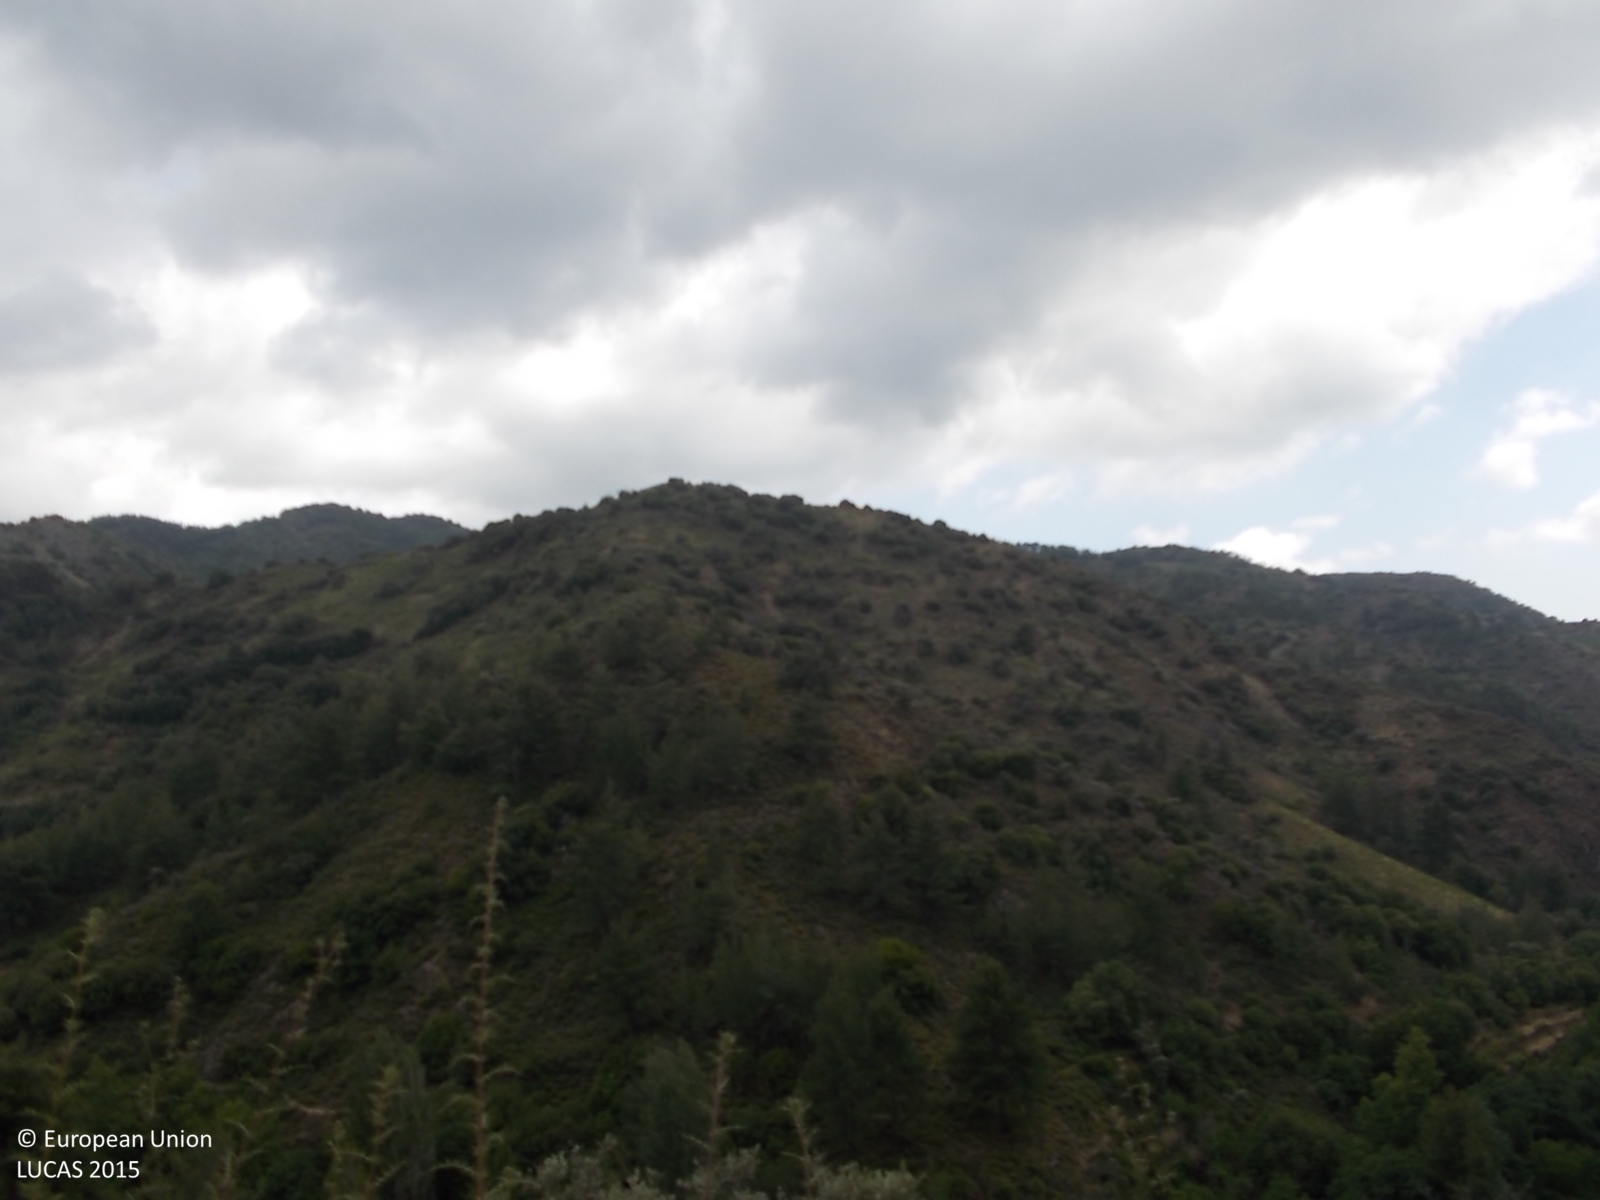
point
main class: Woodland
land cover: Pine dominated coniferous woodland
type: coniferous forest of the mediterranean region
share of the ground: 10 - 25 %
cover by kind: shrubs 35 %, coniferous forest trees 25 %, unconsolidated bare surface 25 %, herbaceous plants 15 %
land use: Forestry
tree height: > 5 m
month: June
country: CY
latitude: 34.9225
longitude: 32.7895
